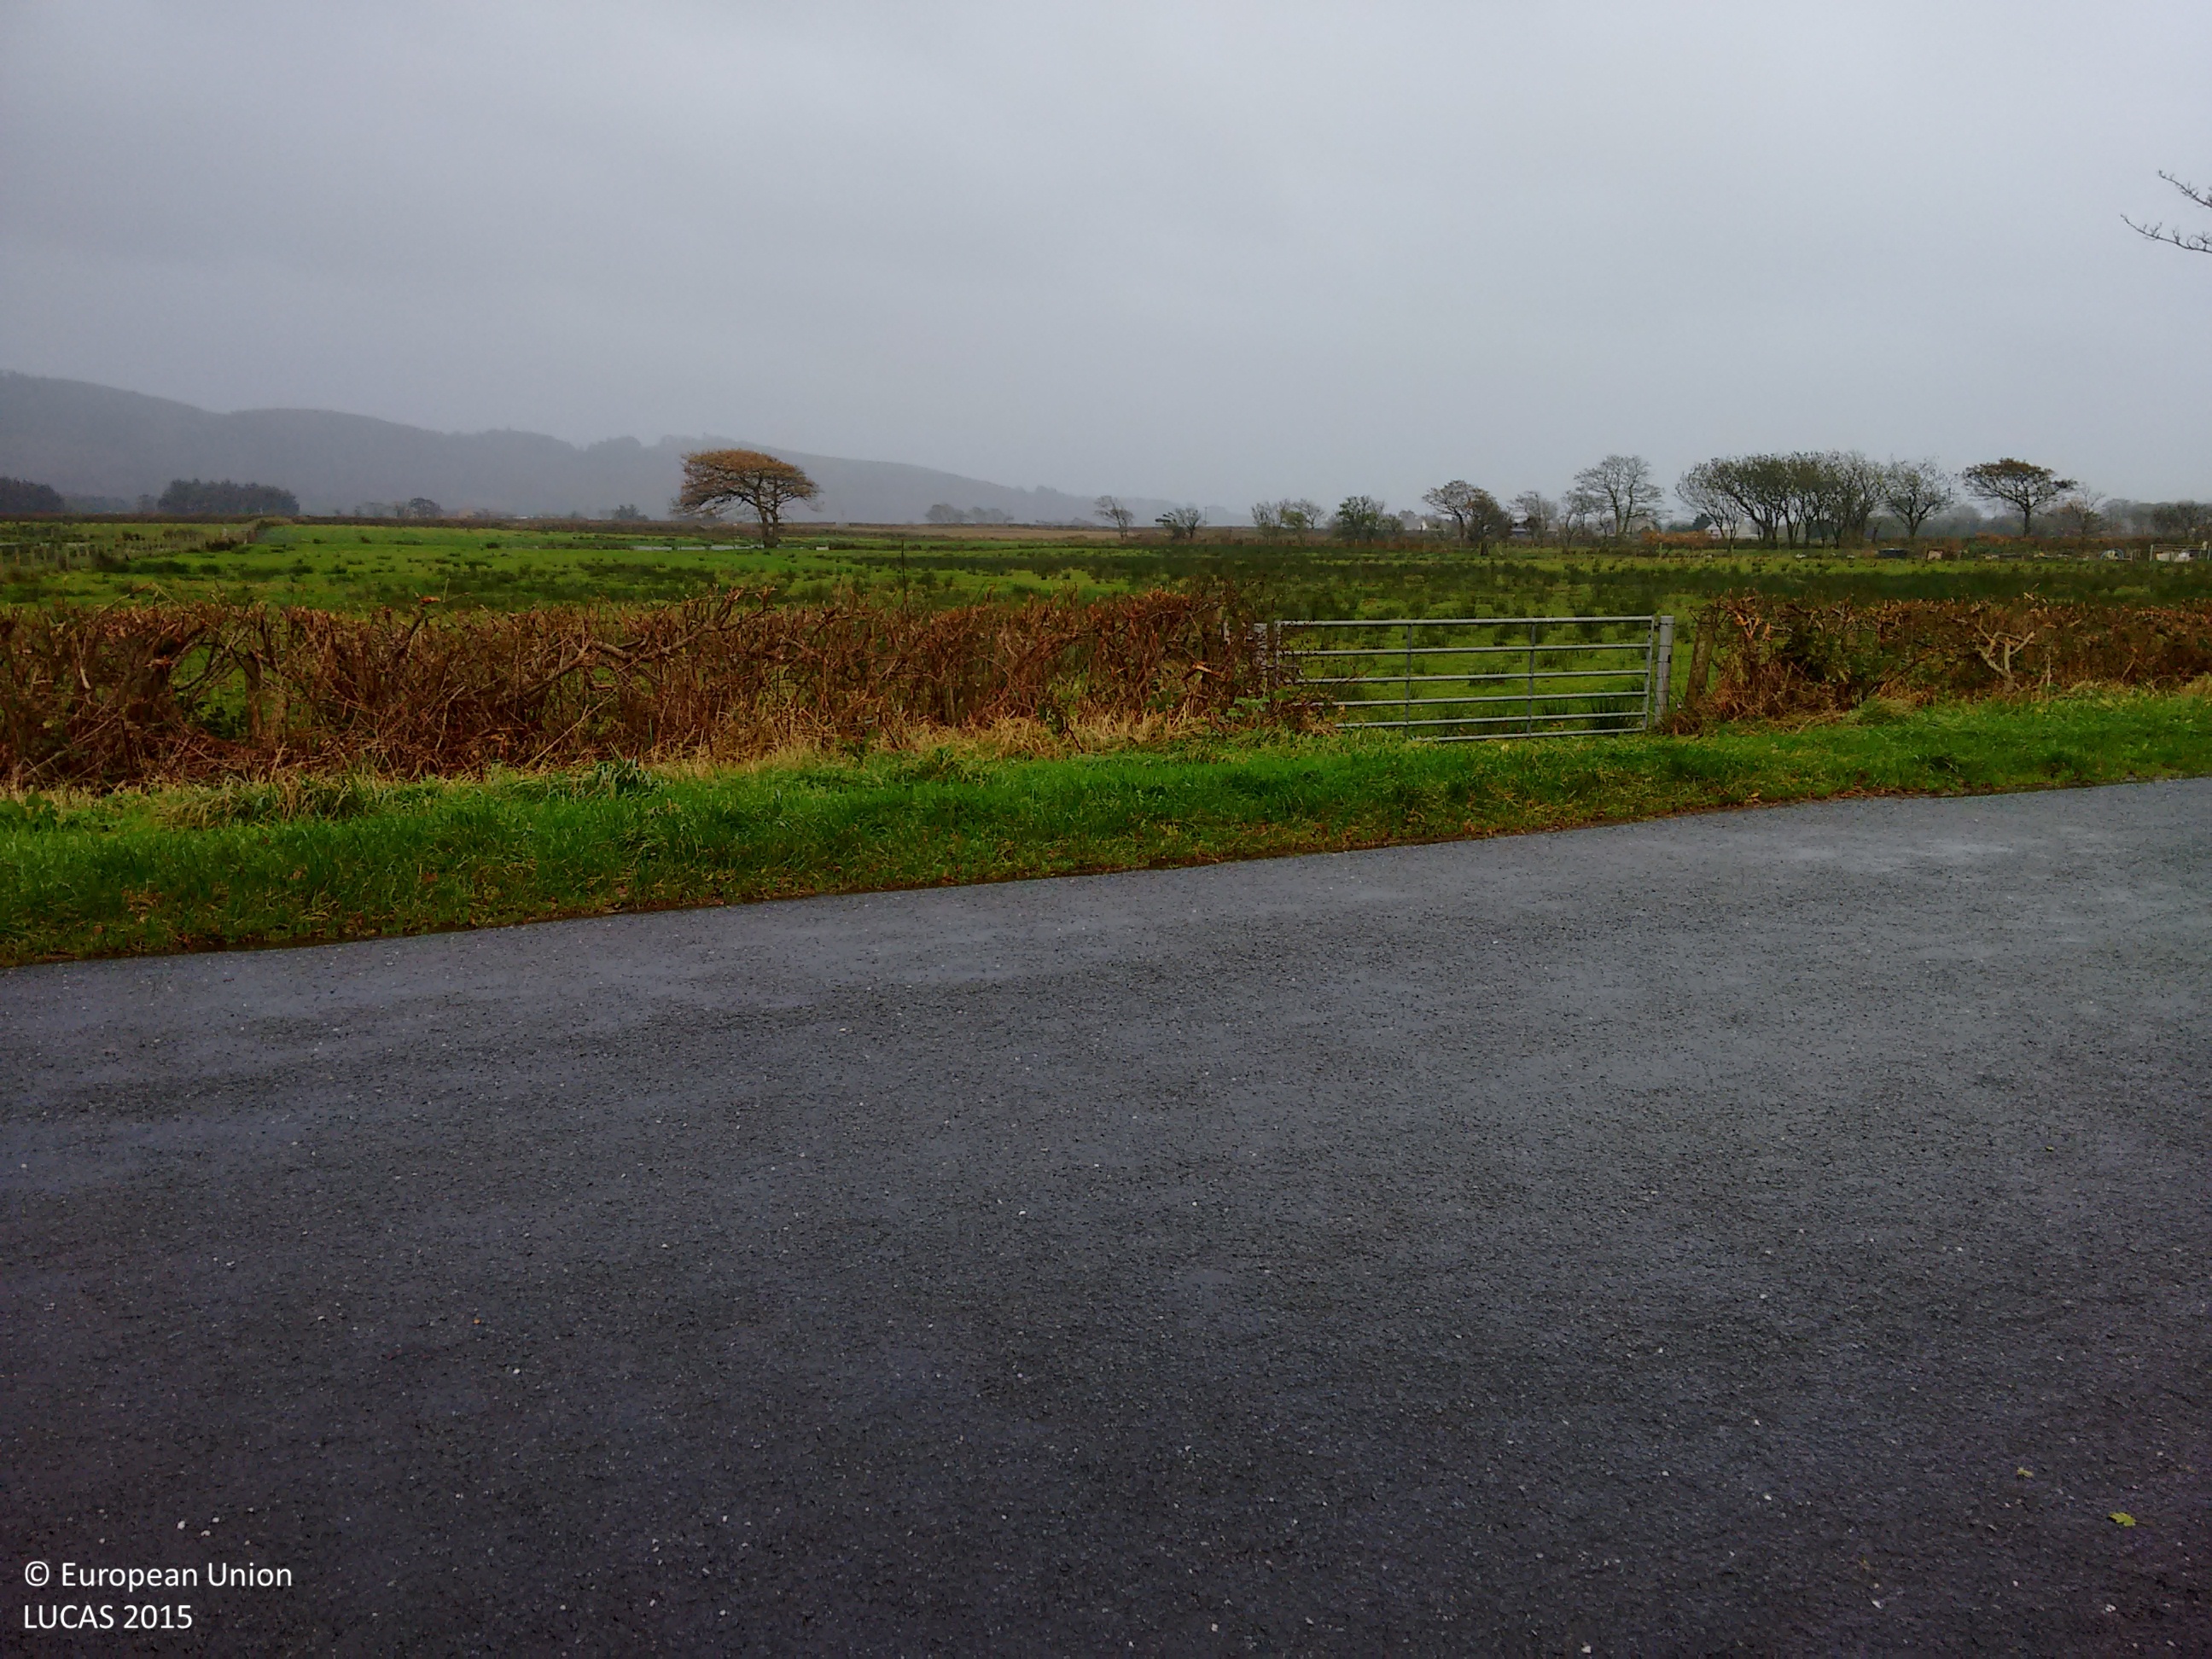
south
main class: Grassland
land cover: Grassland without tree/shrub cover
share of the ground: > 75 %
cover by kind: herbaceous plants 100 %
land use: Agriculture (excluding fallow land and kitchen gardens)
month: November
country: GB
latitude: 54.3857
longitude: -3.3998
